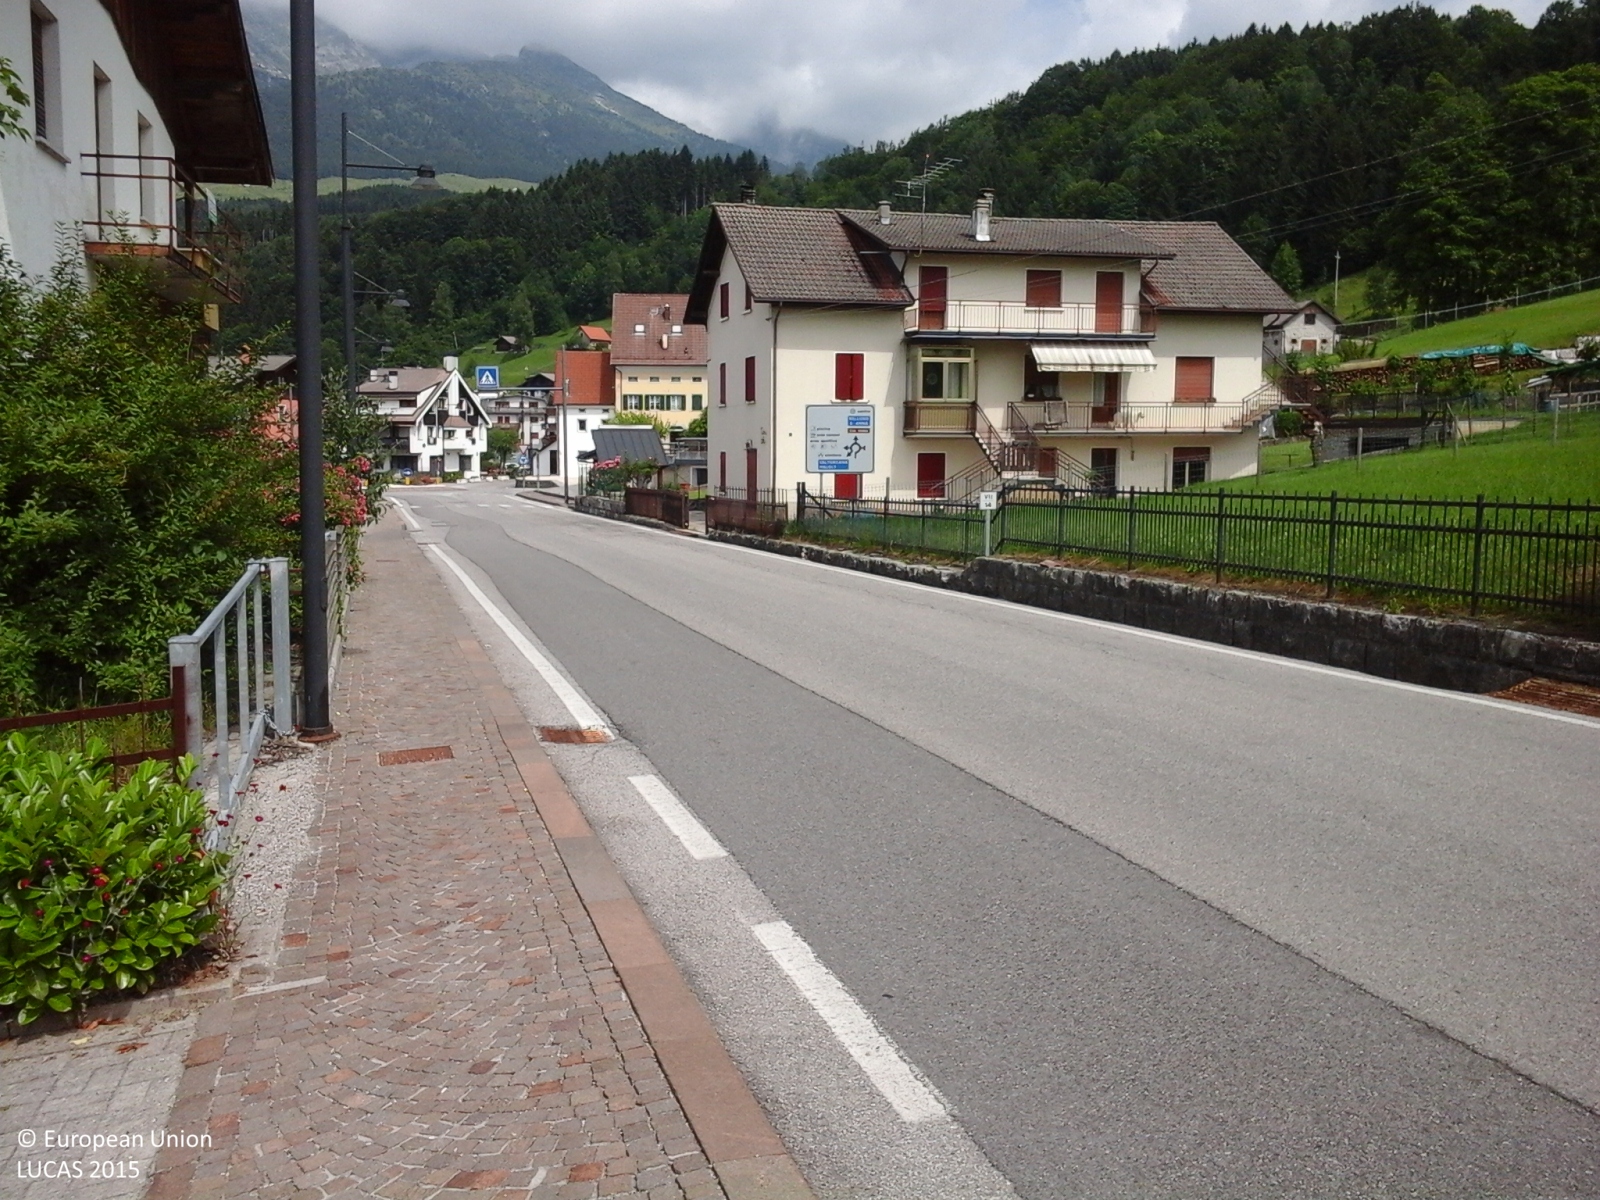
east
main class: Grassland
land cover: Grassland with sparse tree/shrub cover
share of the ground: > 75 %
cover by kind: herbaceous plants 95 %, broadleaved forest trees 5 %
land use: Residential
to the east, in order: Grassland with sparse tree/shrub cover; Artificial constructions in urban areas
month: June
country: IT
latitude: 46.1257
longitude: 12.4171
